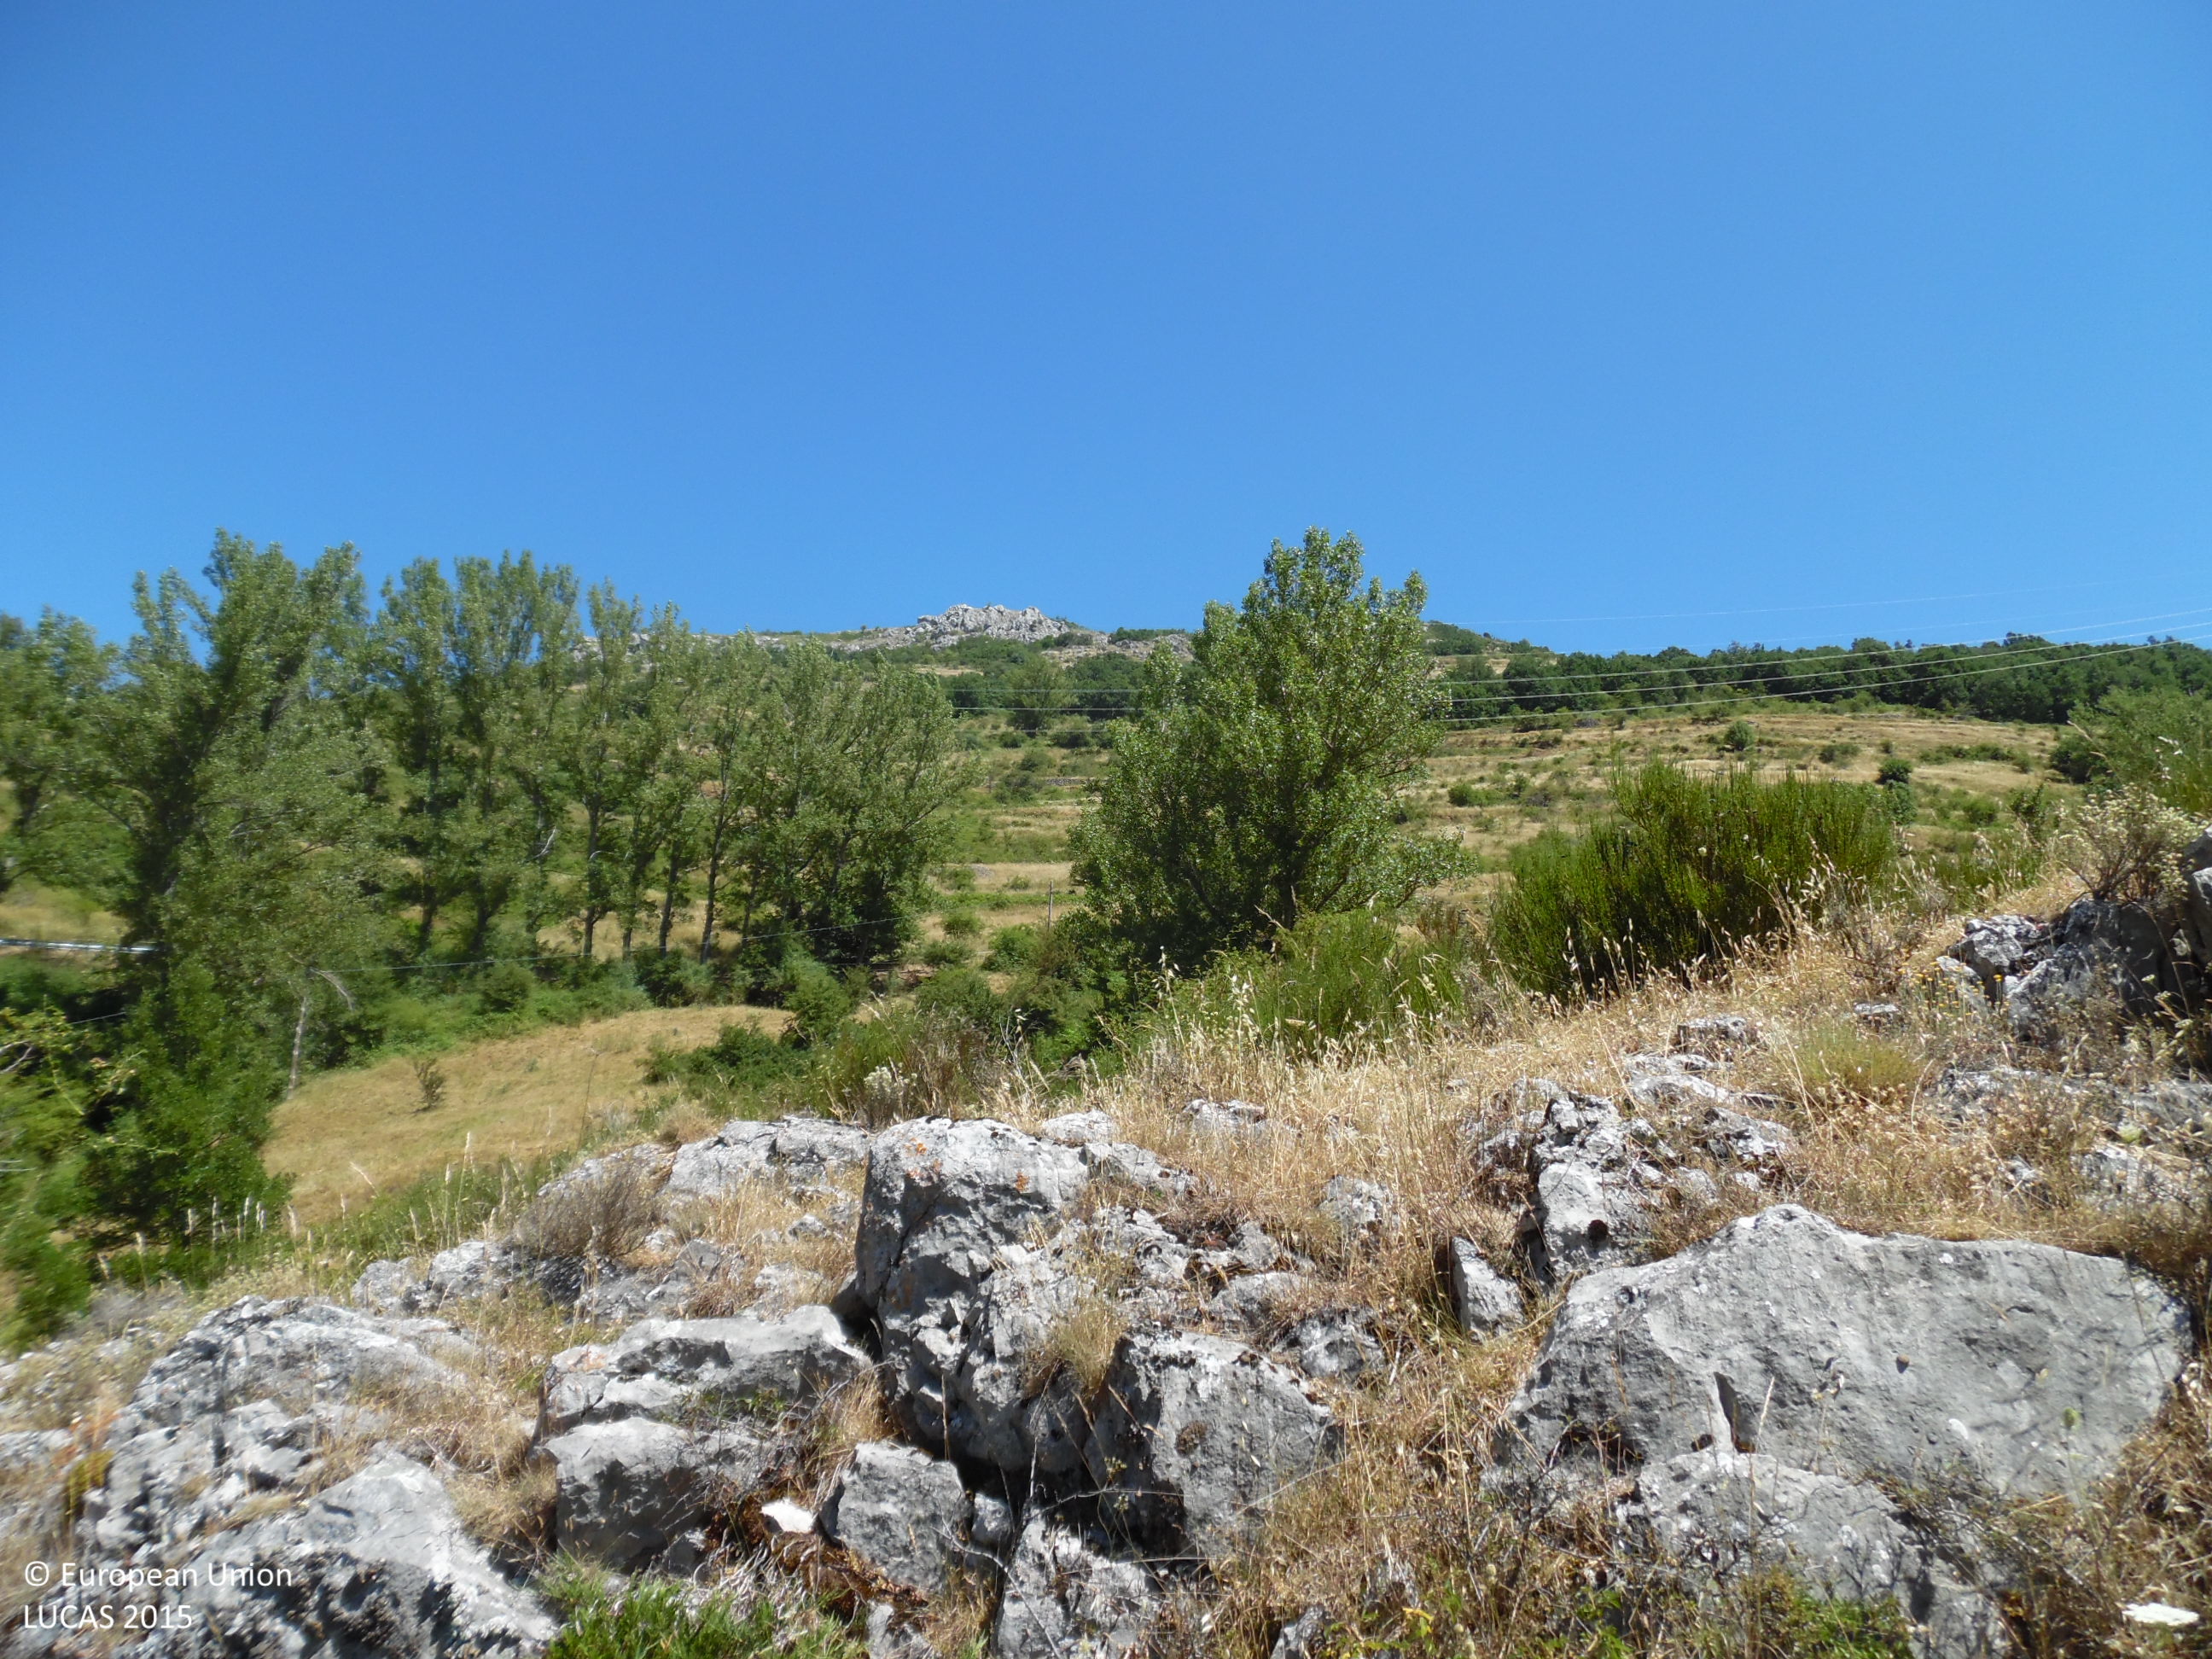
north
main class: Grassland
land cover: Grassland with sparse tree/shrub cover
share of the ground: > 75 %
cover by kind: herbaceous plants 90 %, broadleaved forest trees 5 %, shrubs 5 %
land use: Agriculture (excluding fallow land and kitchen gardens)
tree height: < 5 m
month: July
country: ES
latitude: 42.8834
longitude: -5.7393
